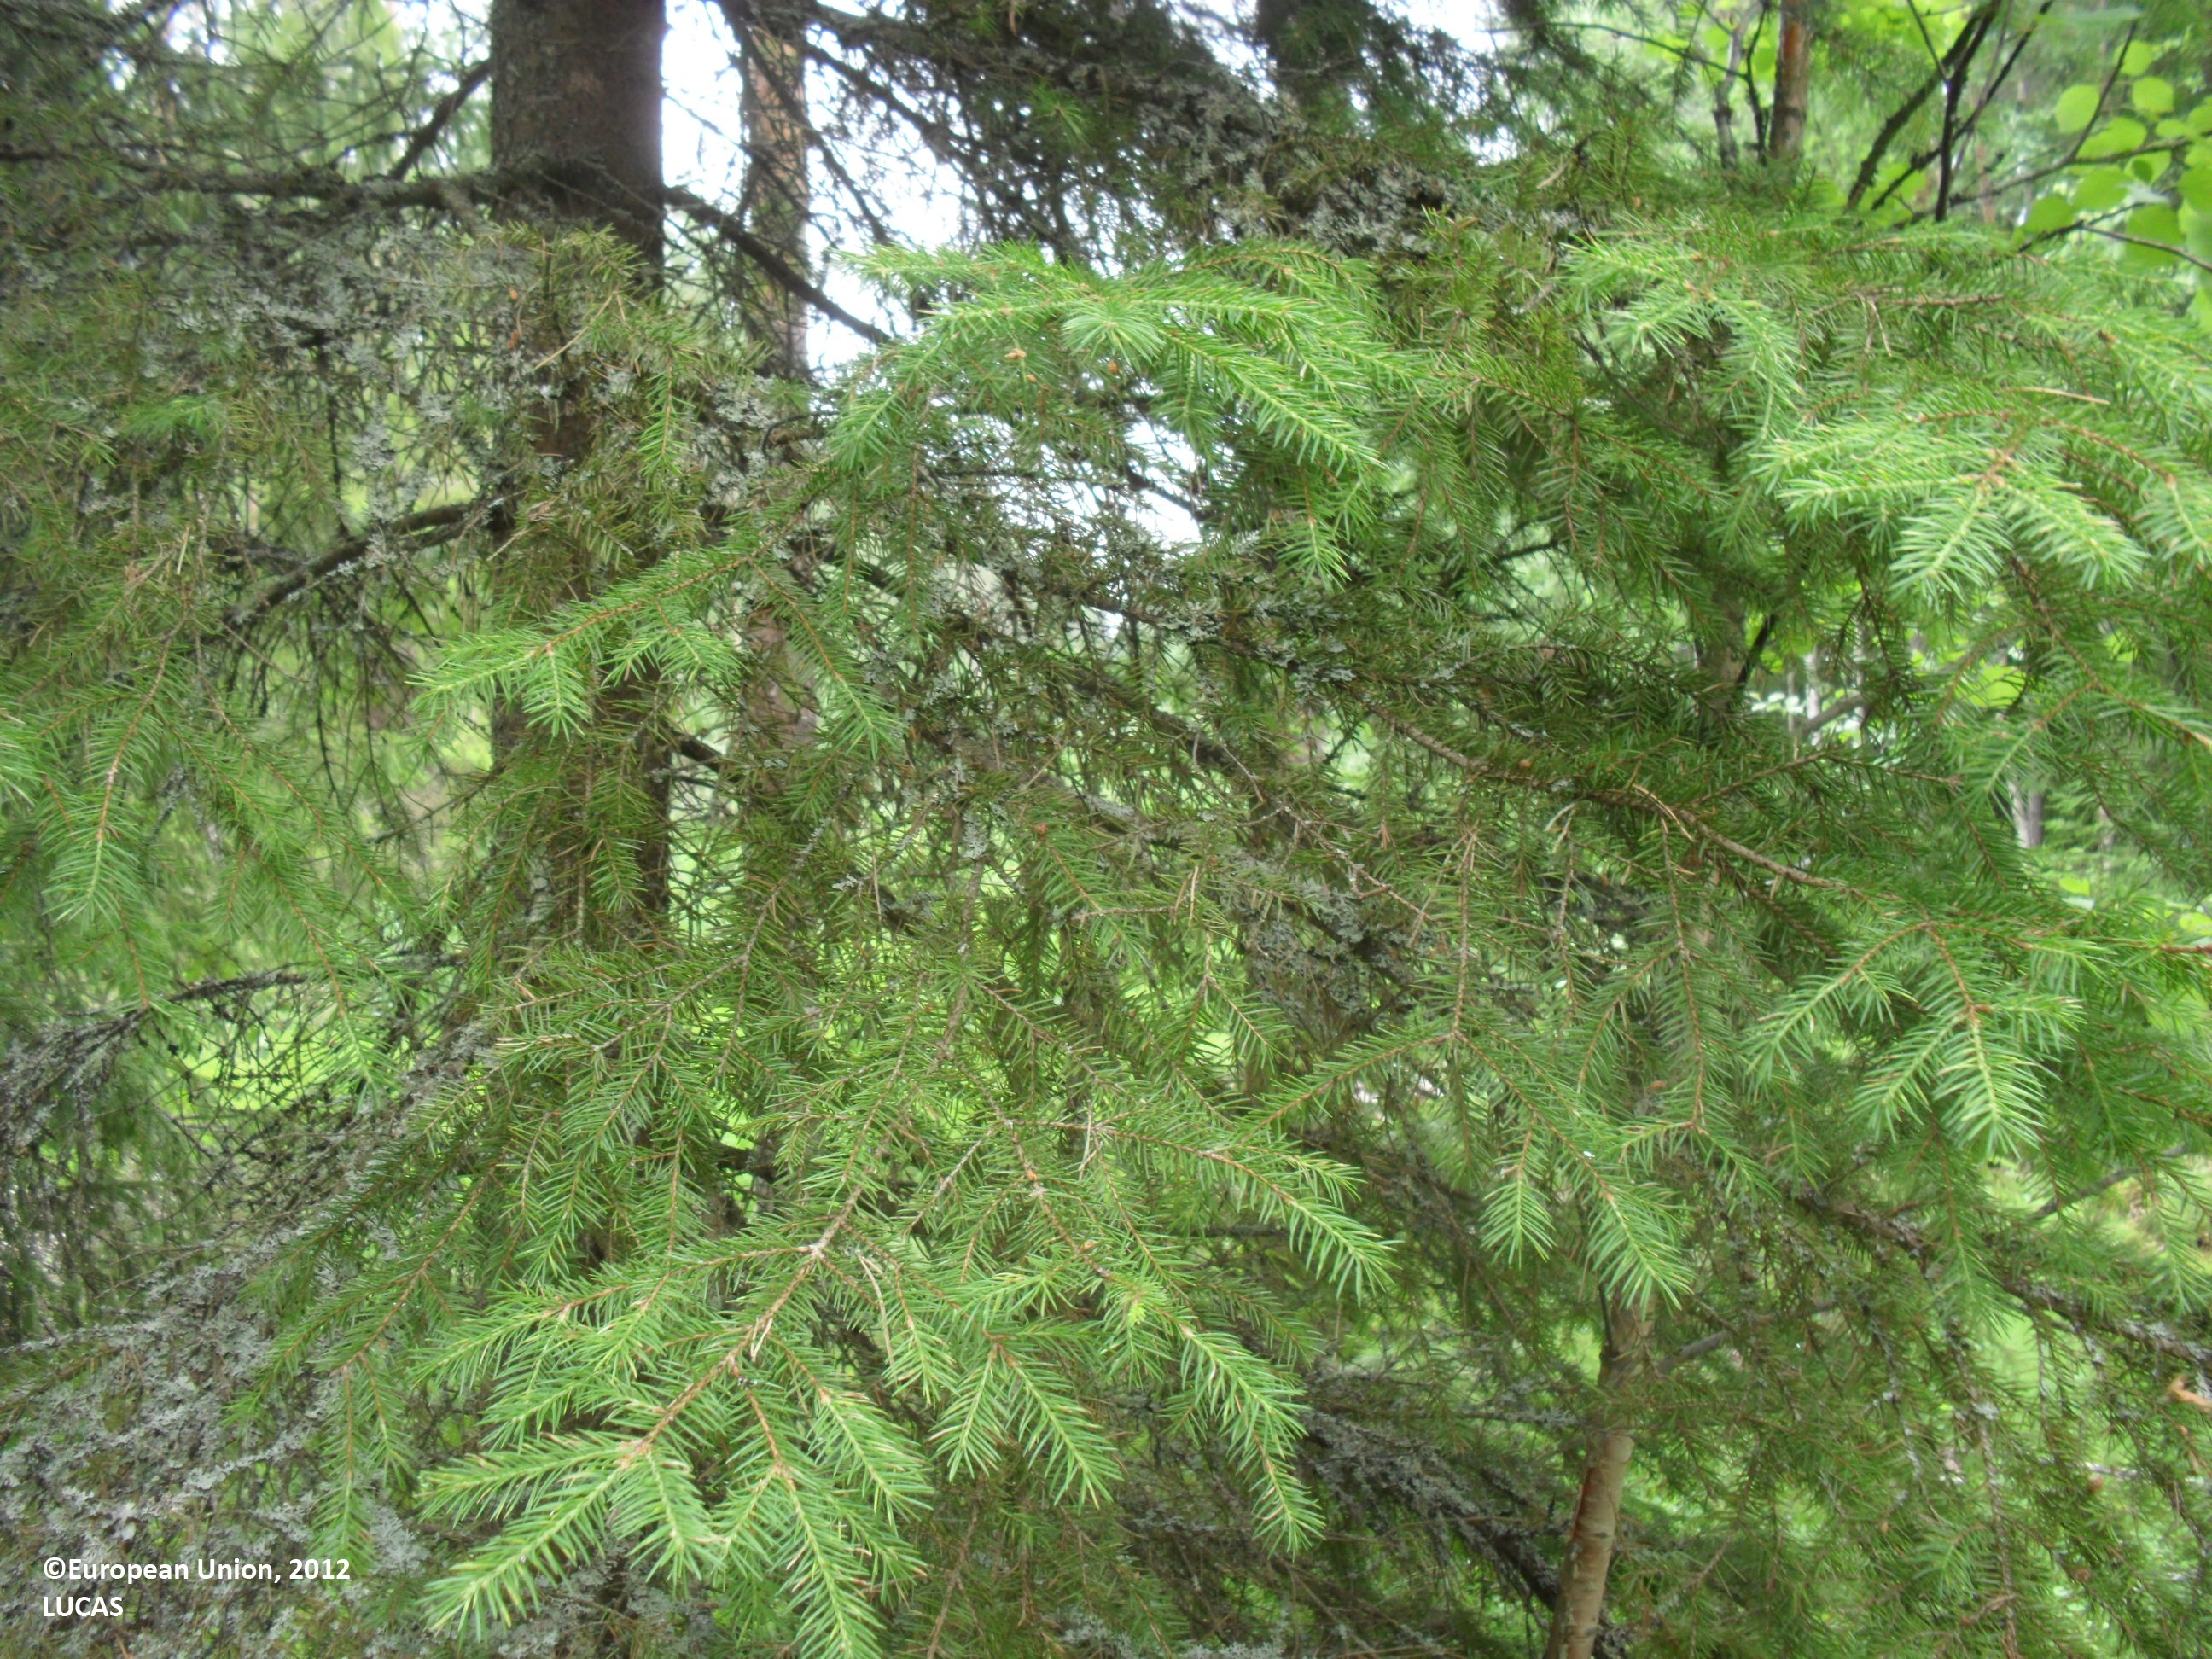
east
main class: Woodland
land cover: Other mixed woodland
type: boreal forest
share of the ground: 25 - 50 %
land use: Forestry
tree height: > 5 m
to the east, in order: Other mixed woodland; Tracks; Other mixed woodland; Ditches and canals; Other mixed woodland
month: July
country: FI
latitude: 63.6182
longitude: 23.4742
